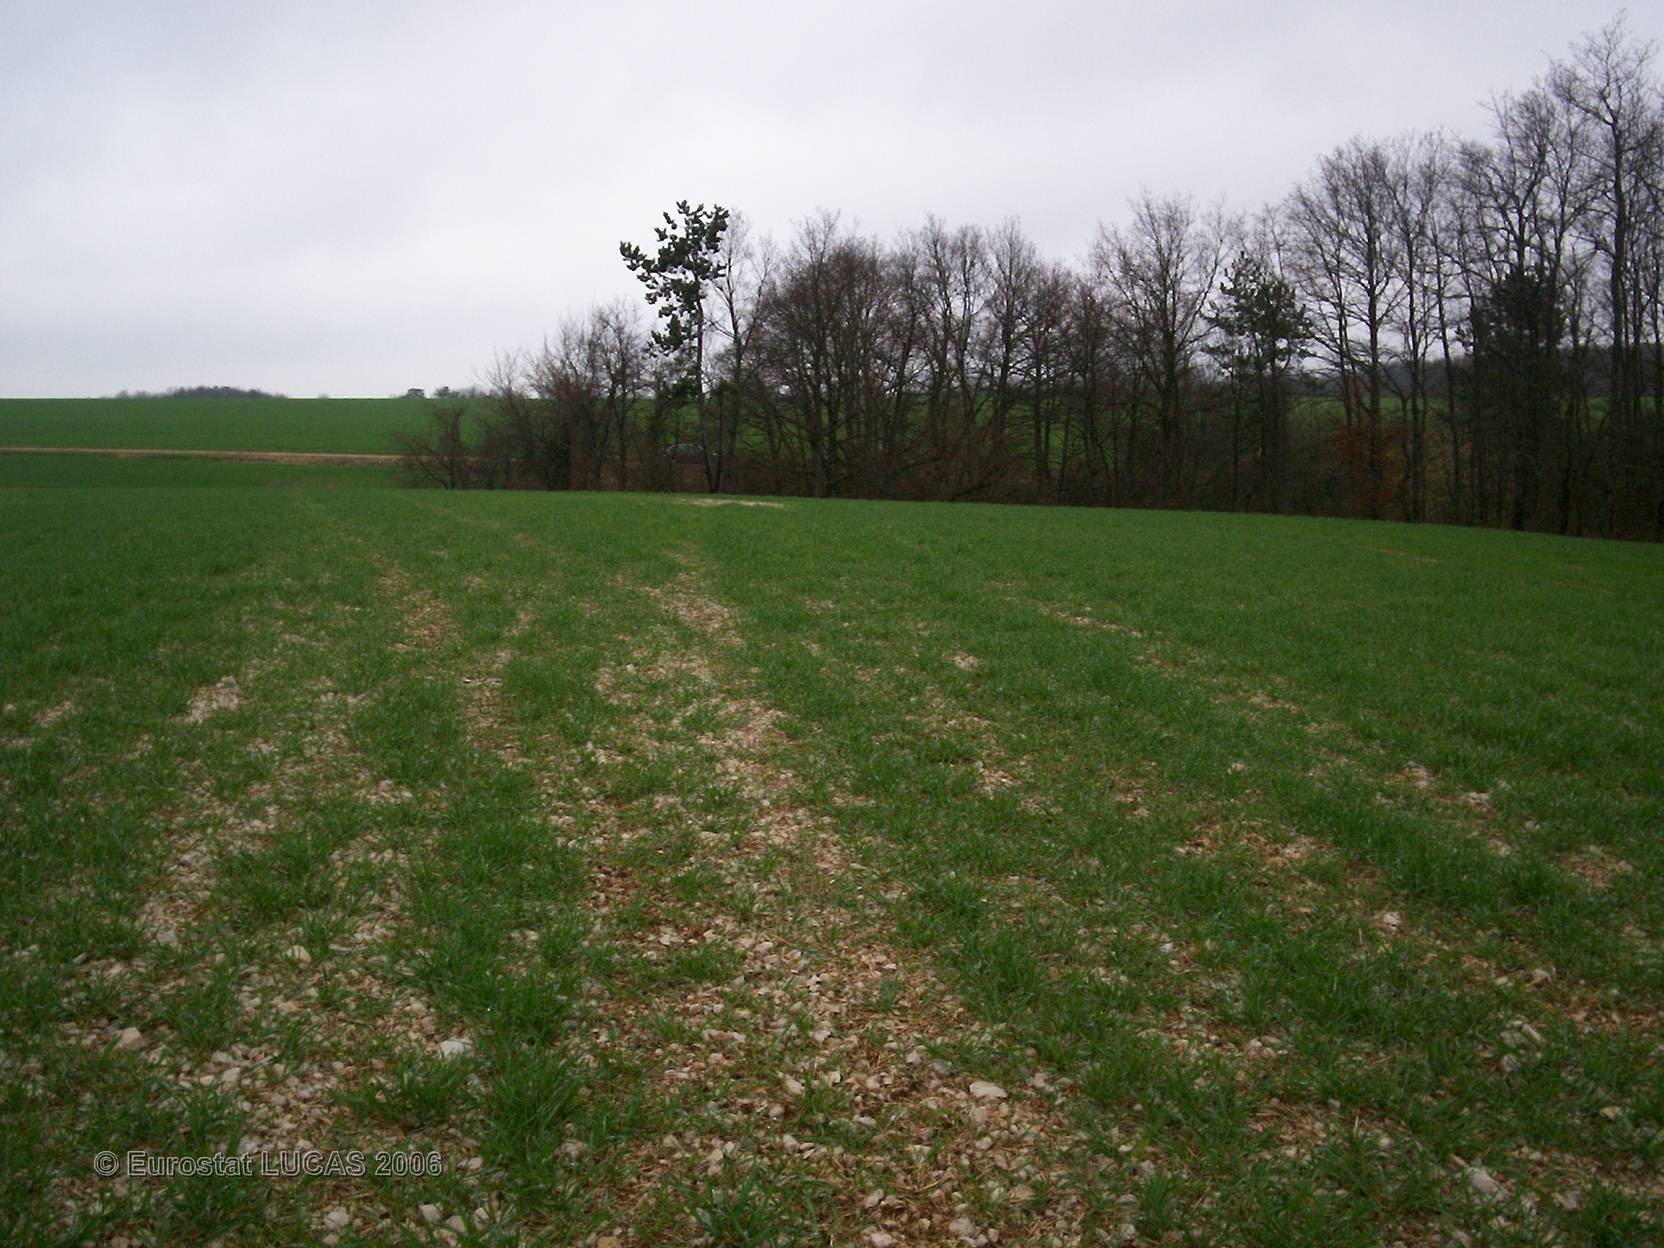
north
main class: Cropland
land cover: Common wheat
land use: Agriculture (excluding fallow land and kitchen gardens)
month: April
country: FR
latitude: 48.1032
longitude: 4.4784
